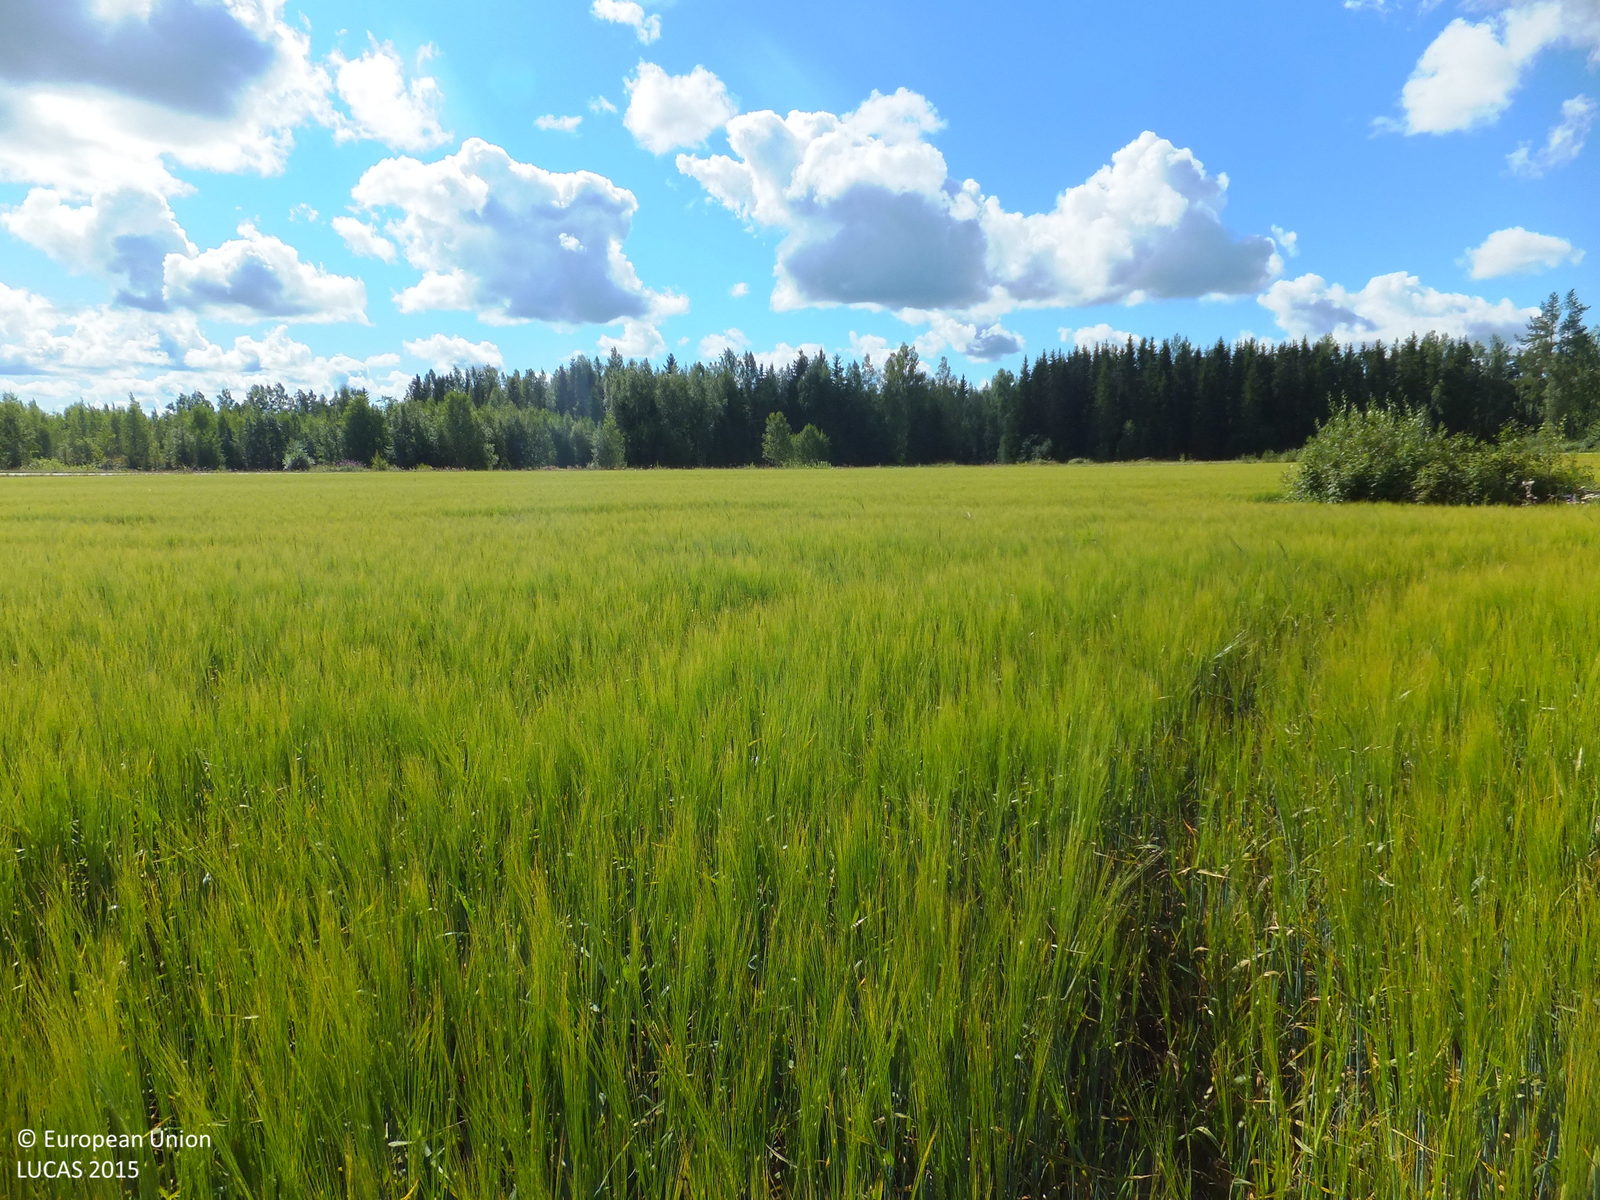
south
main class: Cropland
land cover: Barley
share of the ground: > 75 %
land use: Agriculture (excluding fallow land and kitchen gardens)
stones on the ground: < 10 %
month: August
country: FI
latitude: 63.0932
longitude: 22.7504
